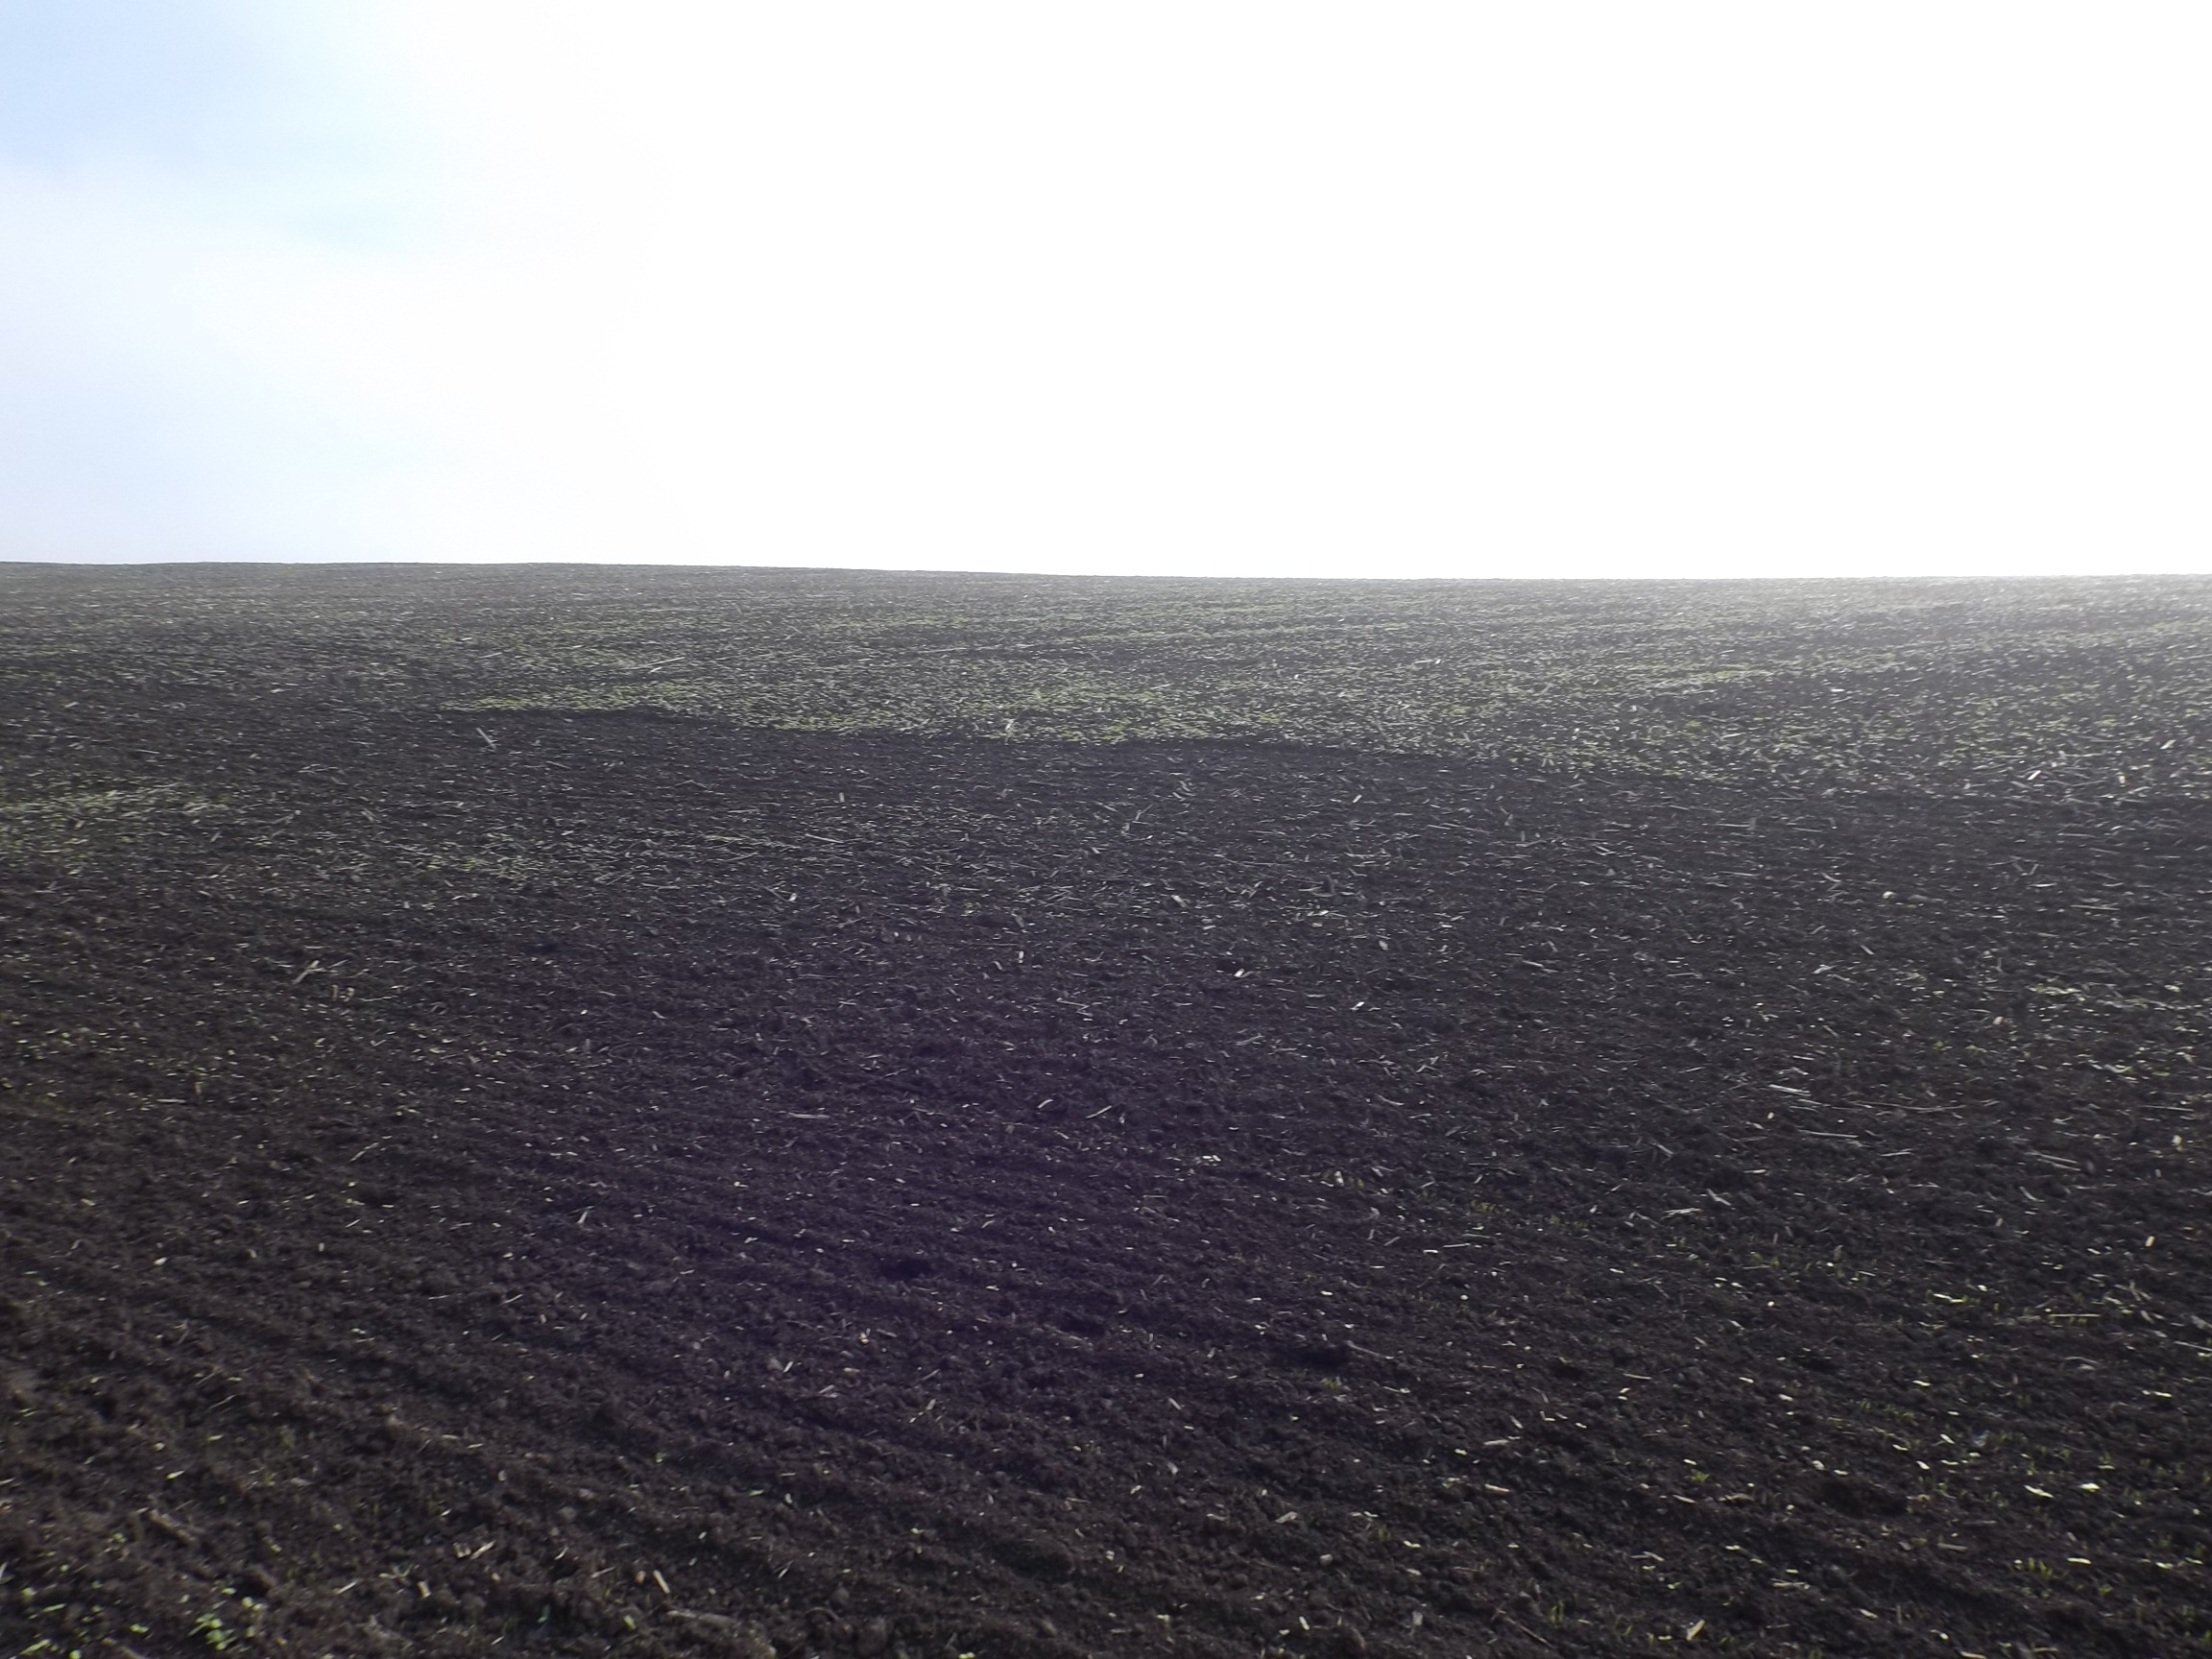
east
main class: Cropland
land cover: Sunflower
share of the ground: < 10 %
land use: Agriculture (excluding fallow land and kitchen gardens)
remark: Harvested field
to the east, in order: Sunflower
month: October
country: BG
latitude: 43.1639
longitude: 27.2784
